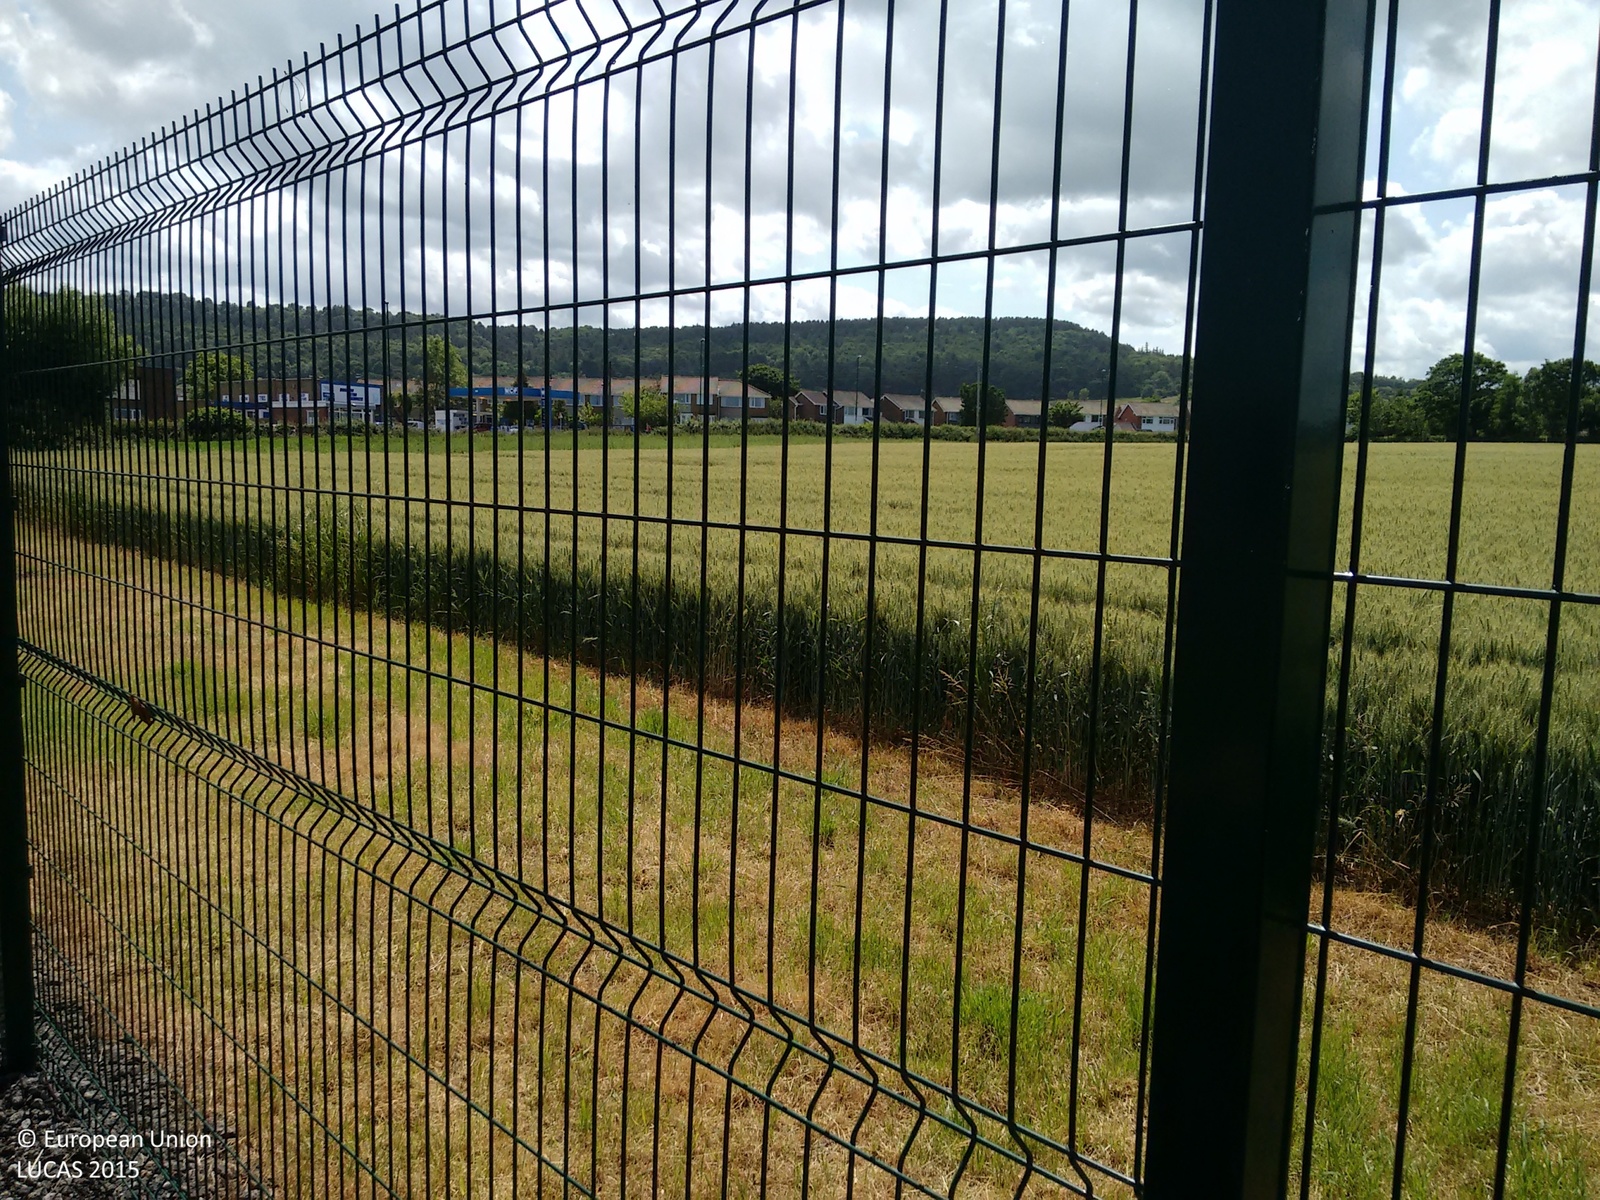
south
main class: Cropland
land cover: Common wheat
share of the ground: > 75 %
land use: Agriculture (excluding fallow land and kitchen gardens)
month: July
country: GB
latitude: 54.5836
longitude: -1.0434
